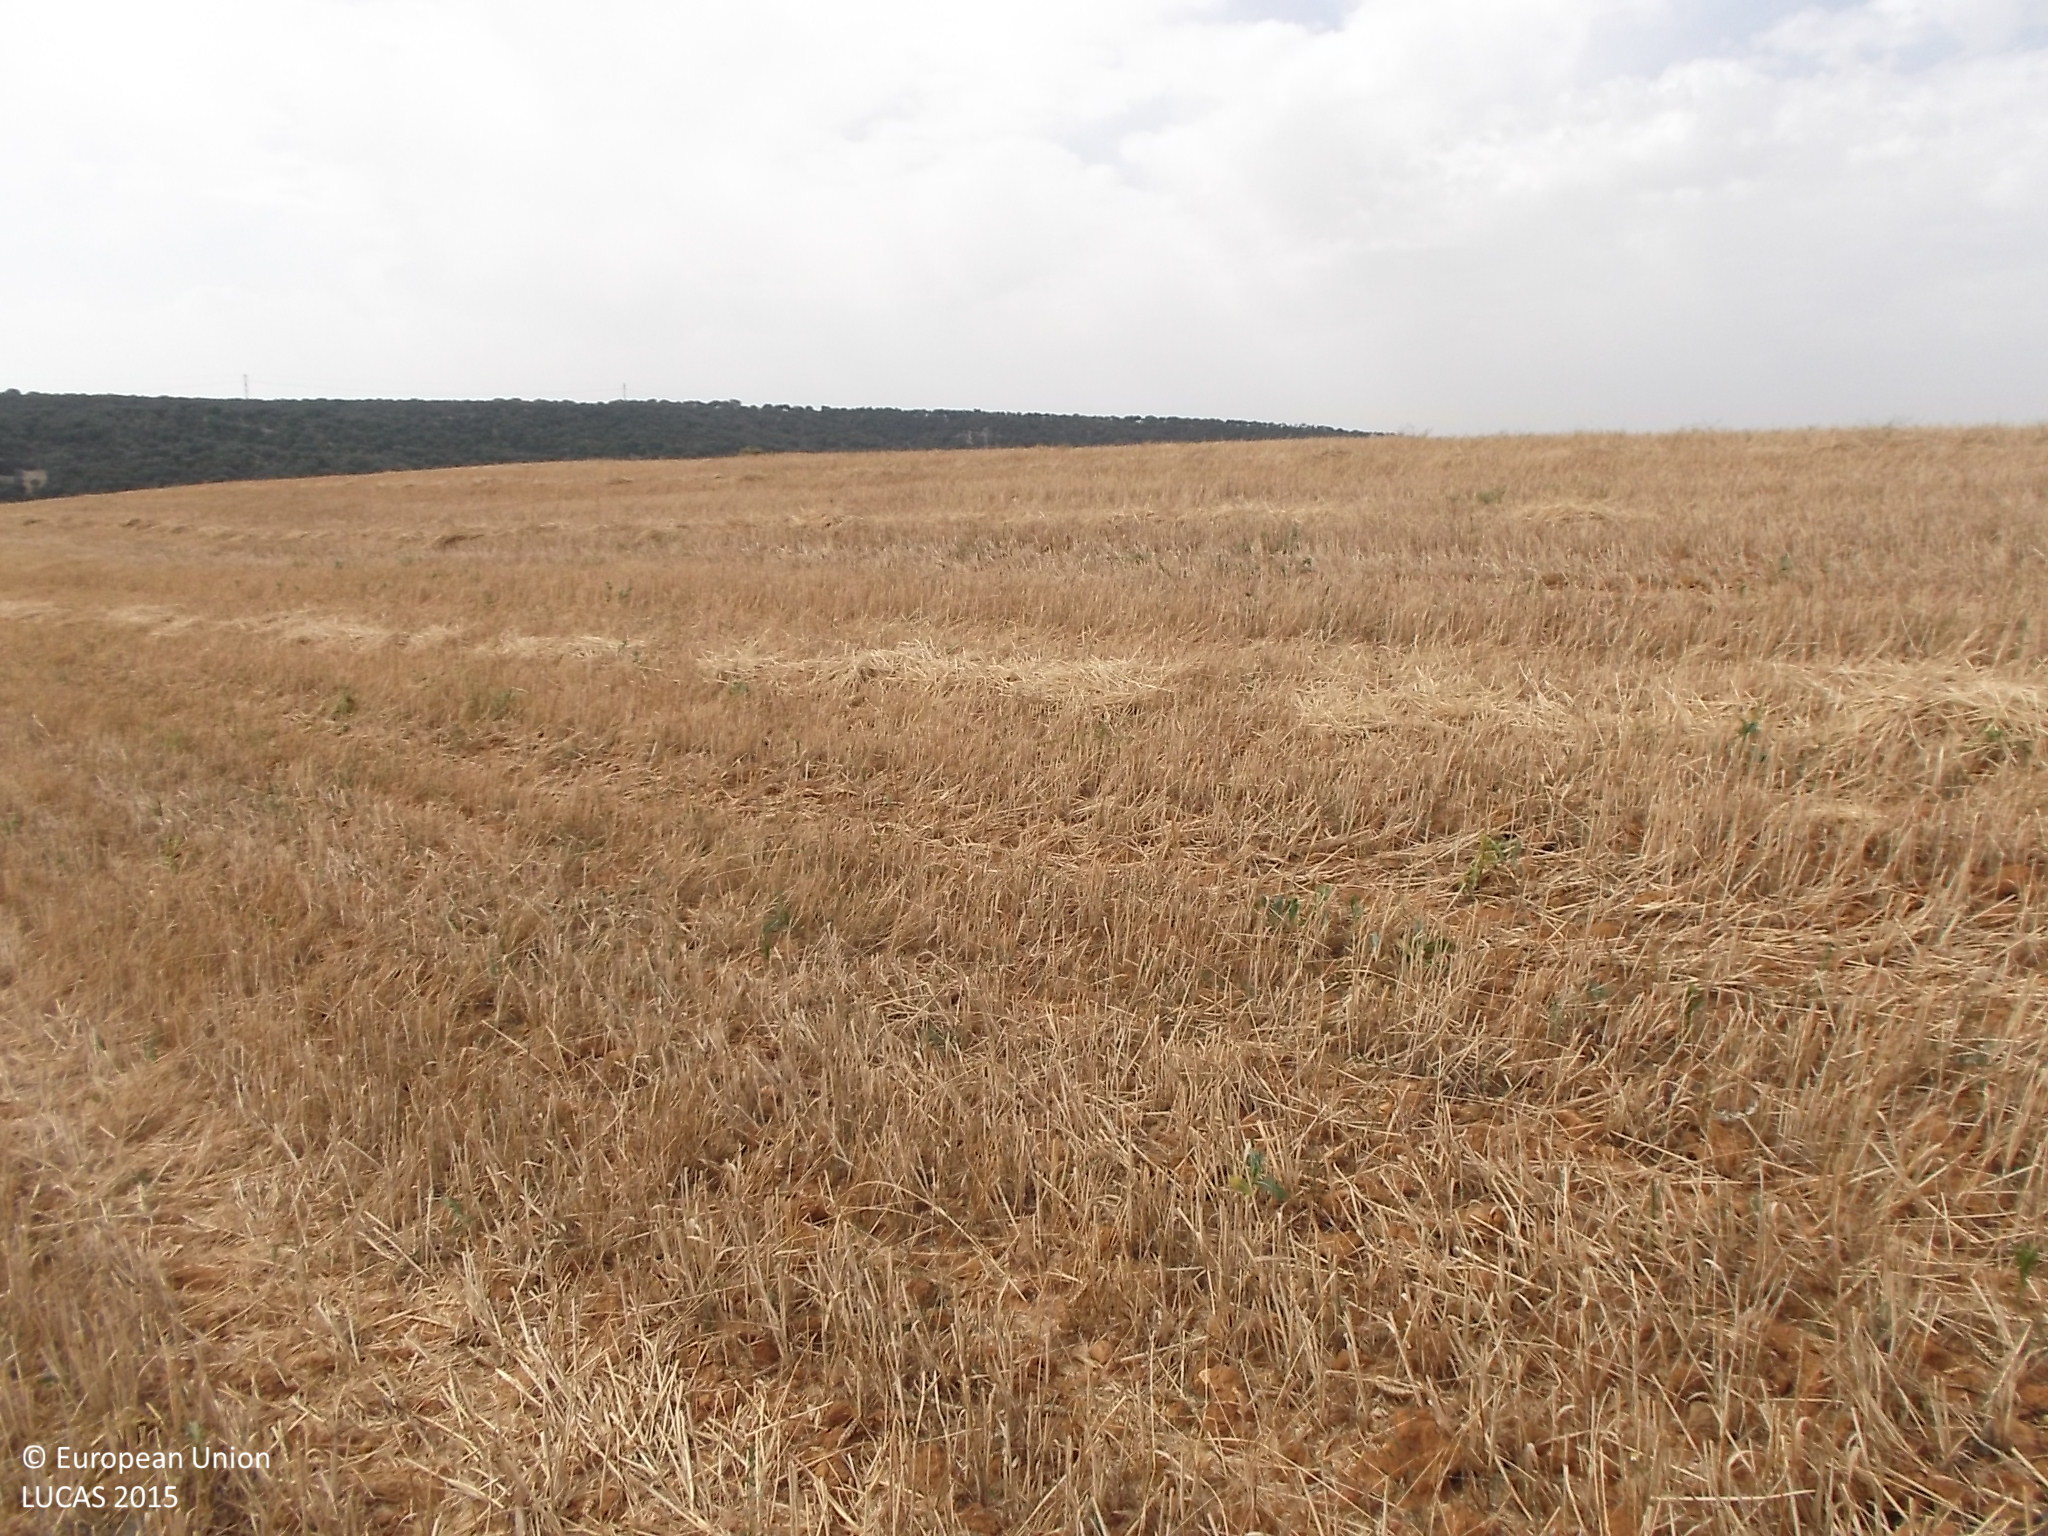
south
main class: Cropland
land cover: Common wheat
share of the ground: < 10 %
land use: Agriculture (excluding fallow land and kitchen gardens)
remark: Harvested field
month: July
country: ES
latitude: 41.5742
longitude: -5.5425
